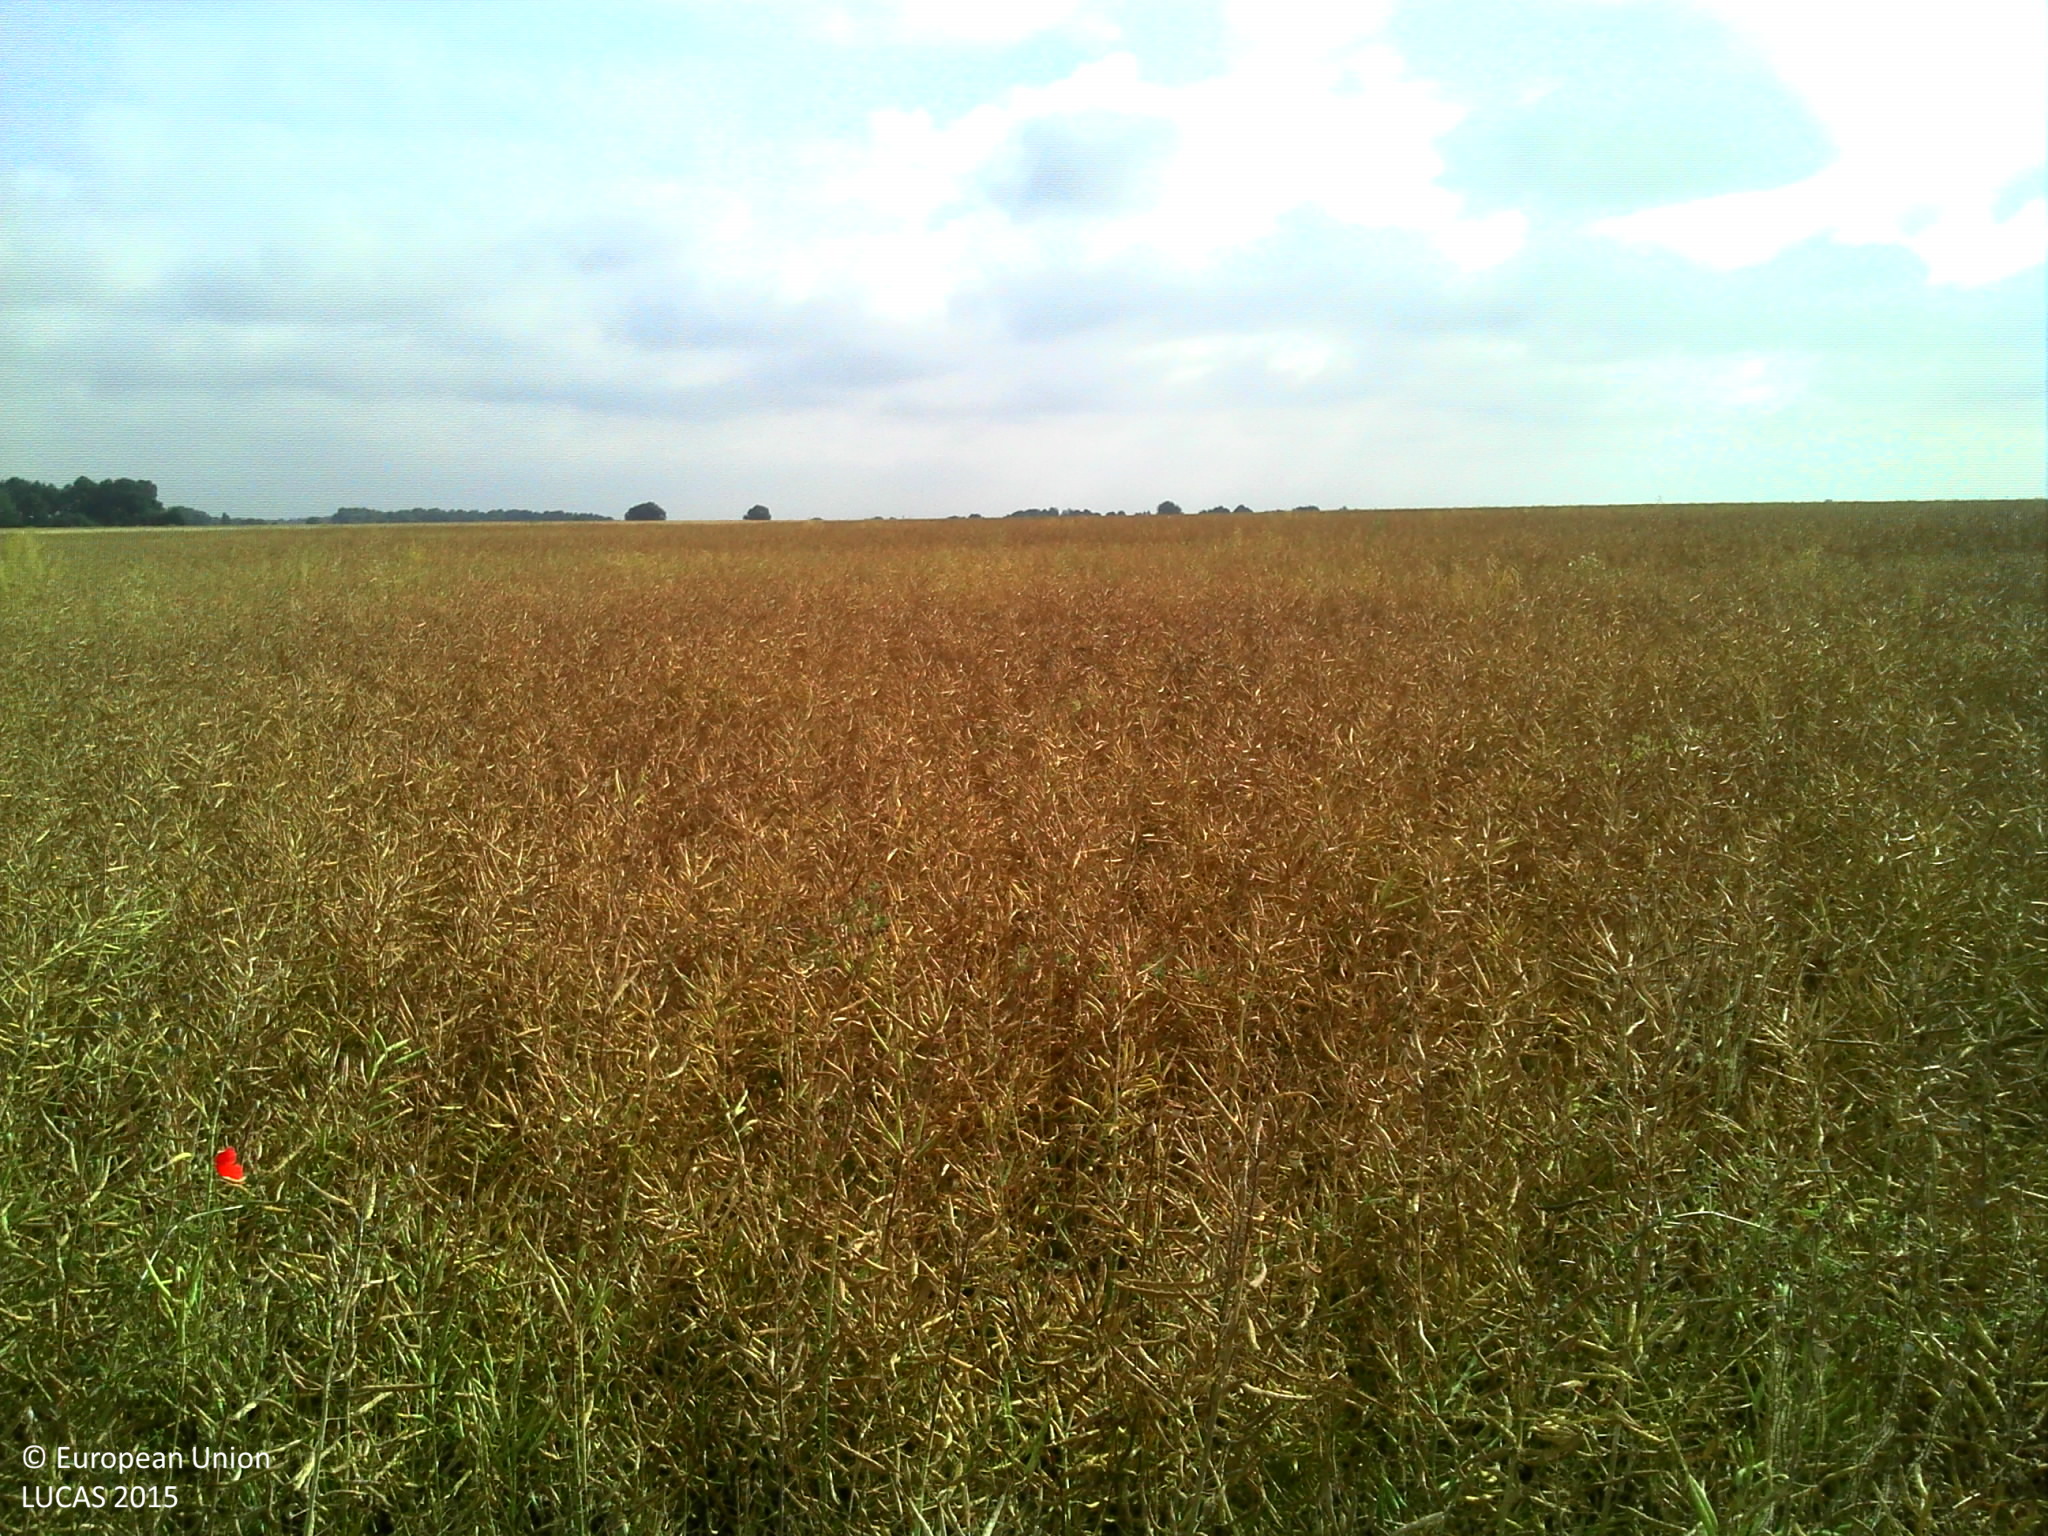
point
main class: Cropland
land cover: Rape and turnip rape
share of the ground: > 75 %
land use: Agriculture (excluding fallow land and kitchen gardens)
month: July
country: FR
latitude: 48.8965
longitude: 0.4665
